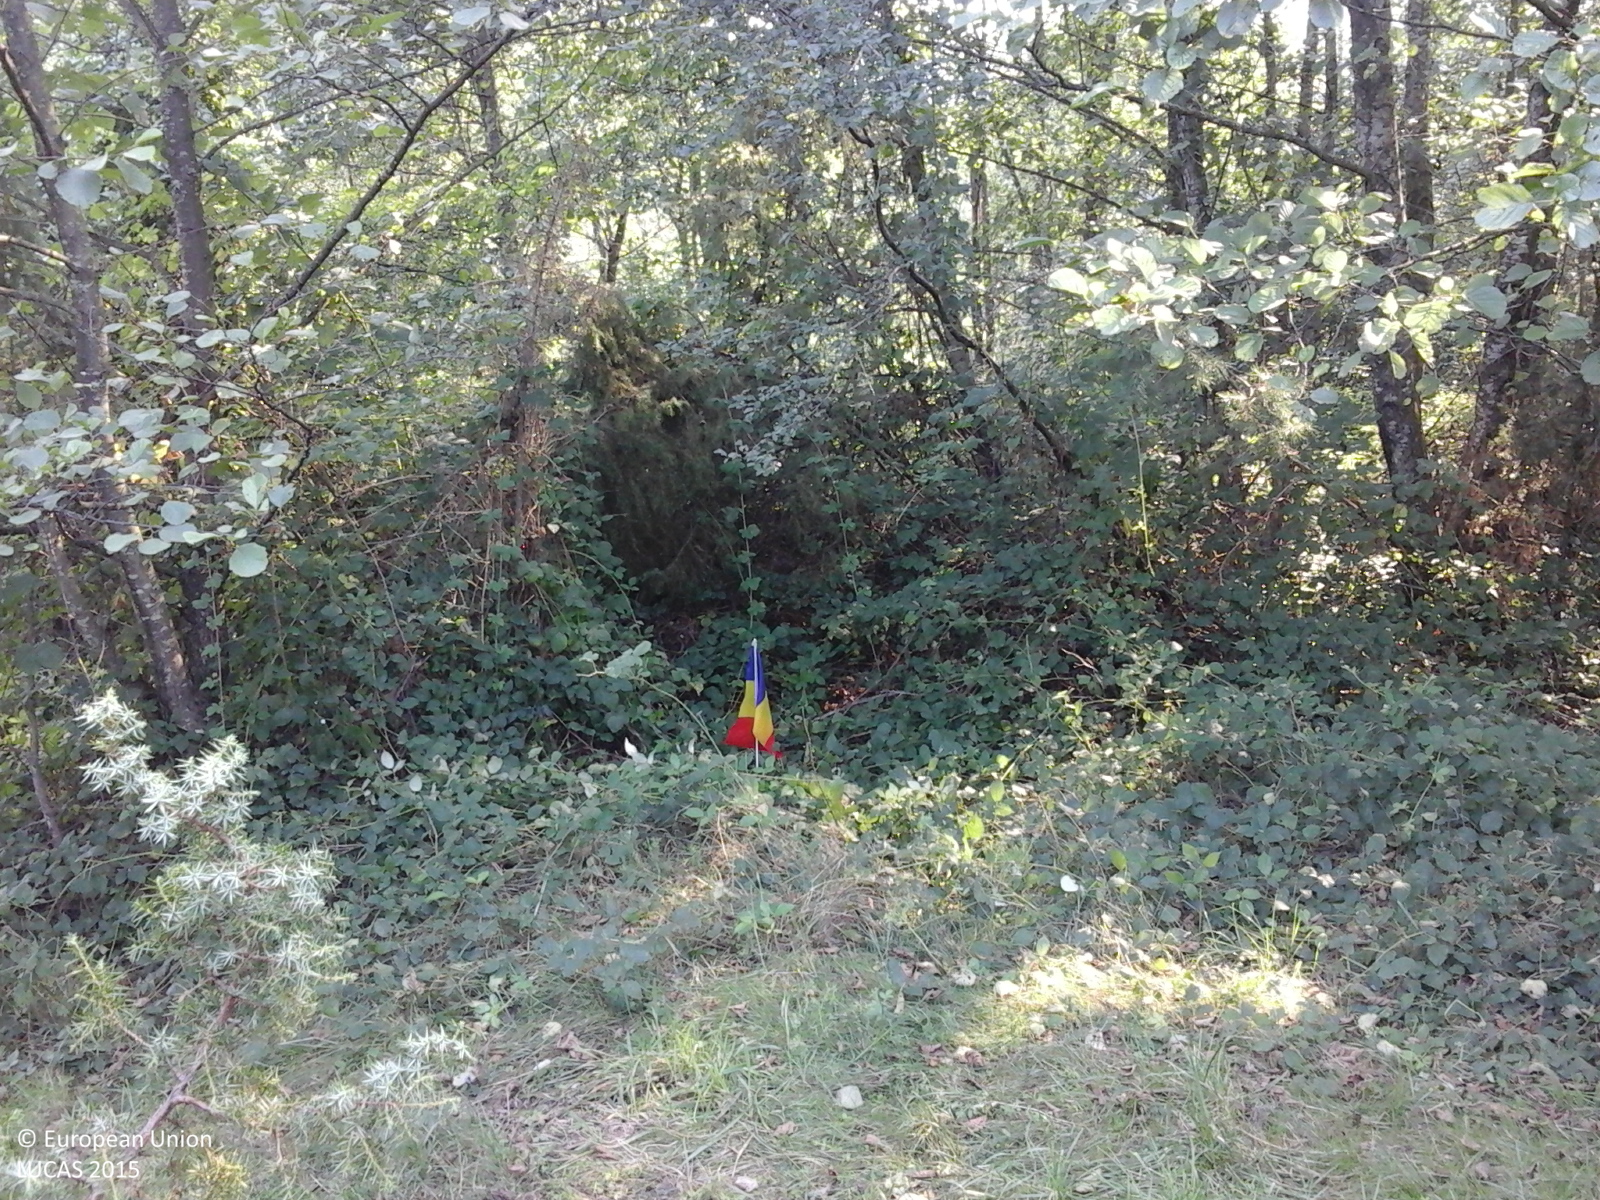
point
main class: Woodland
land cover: Other mixed woodland
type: beech forest
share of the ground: > 75 %
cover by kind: broadleaved forest trees 70 %, coniferous forest trees 30 %
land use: Forestry
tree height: > 5 m
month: August
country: RO
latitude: 46.3066
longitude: 22.5023
